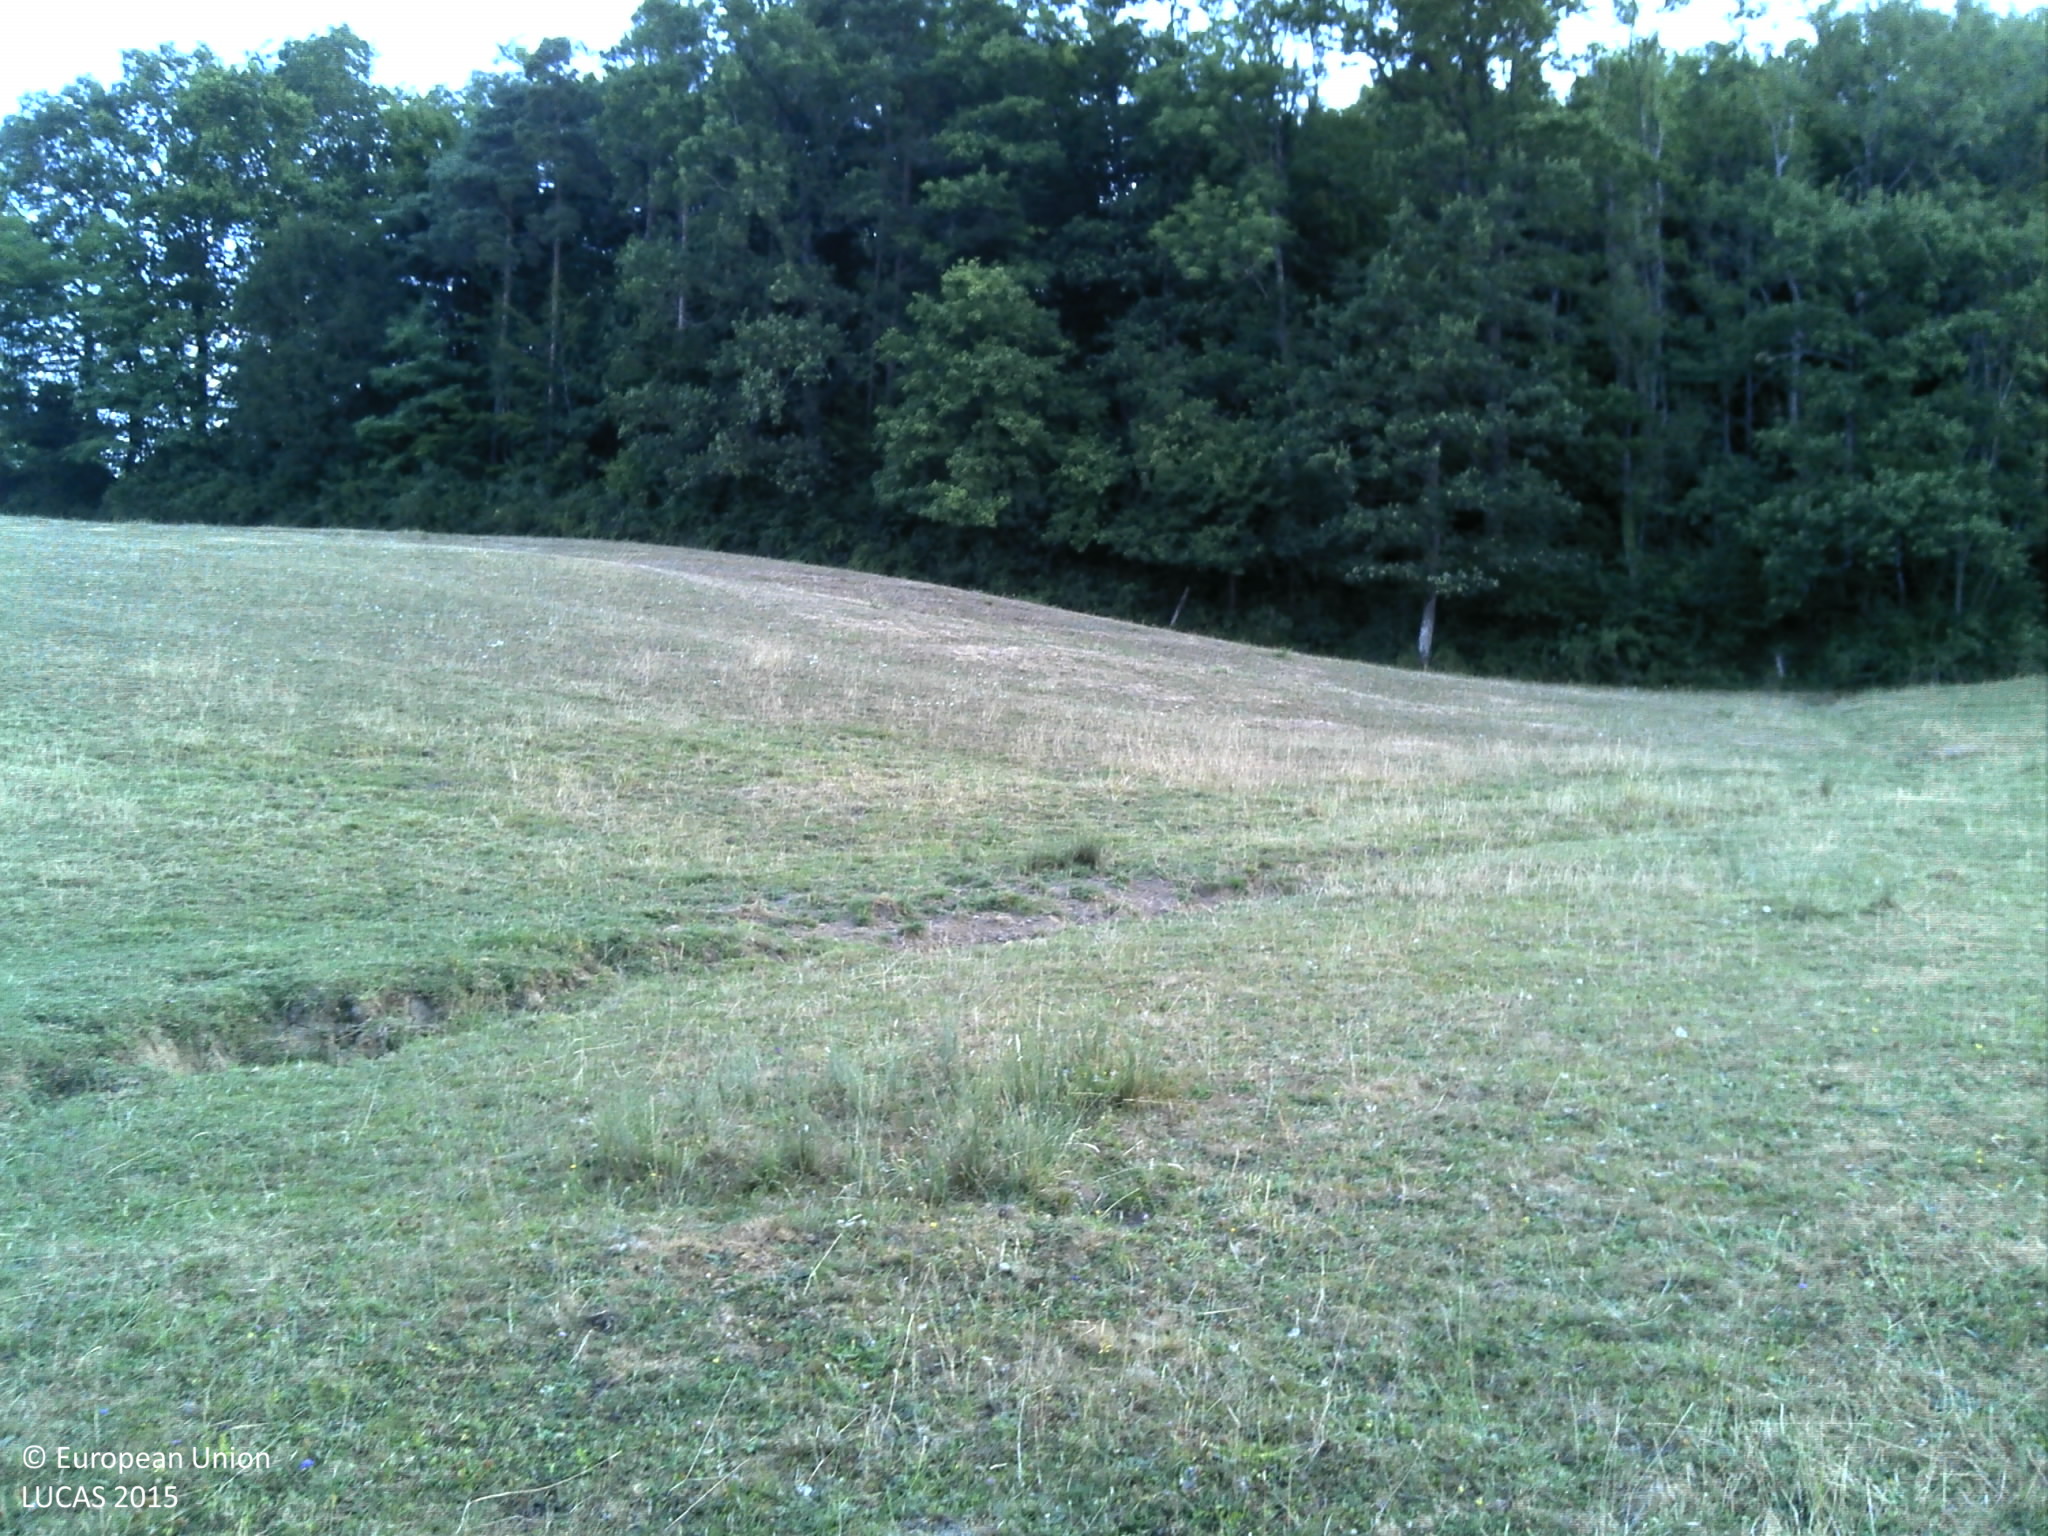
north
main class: Grassland
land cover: Grassland with sparse tree/shrub cover
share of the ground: > 75 %
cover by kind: herbaceous plants 95 %, broadleaved forest trees 5 %
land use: Agriculture (excluding fallow land and kitchen gardens)
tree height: > 5 m
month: July
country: FR
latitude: 48.3017
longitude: 6.1852
